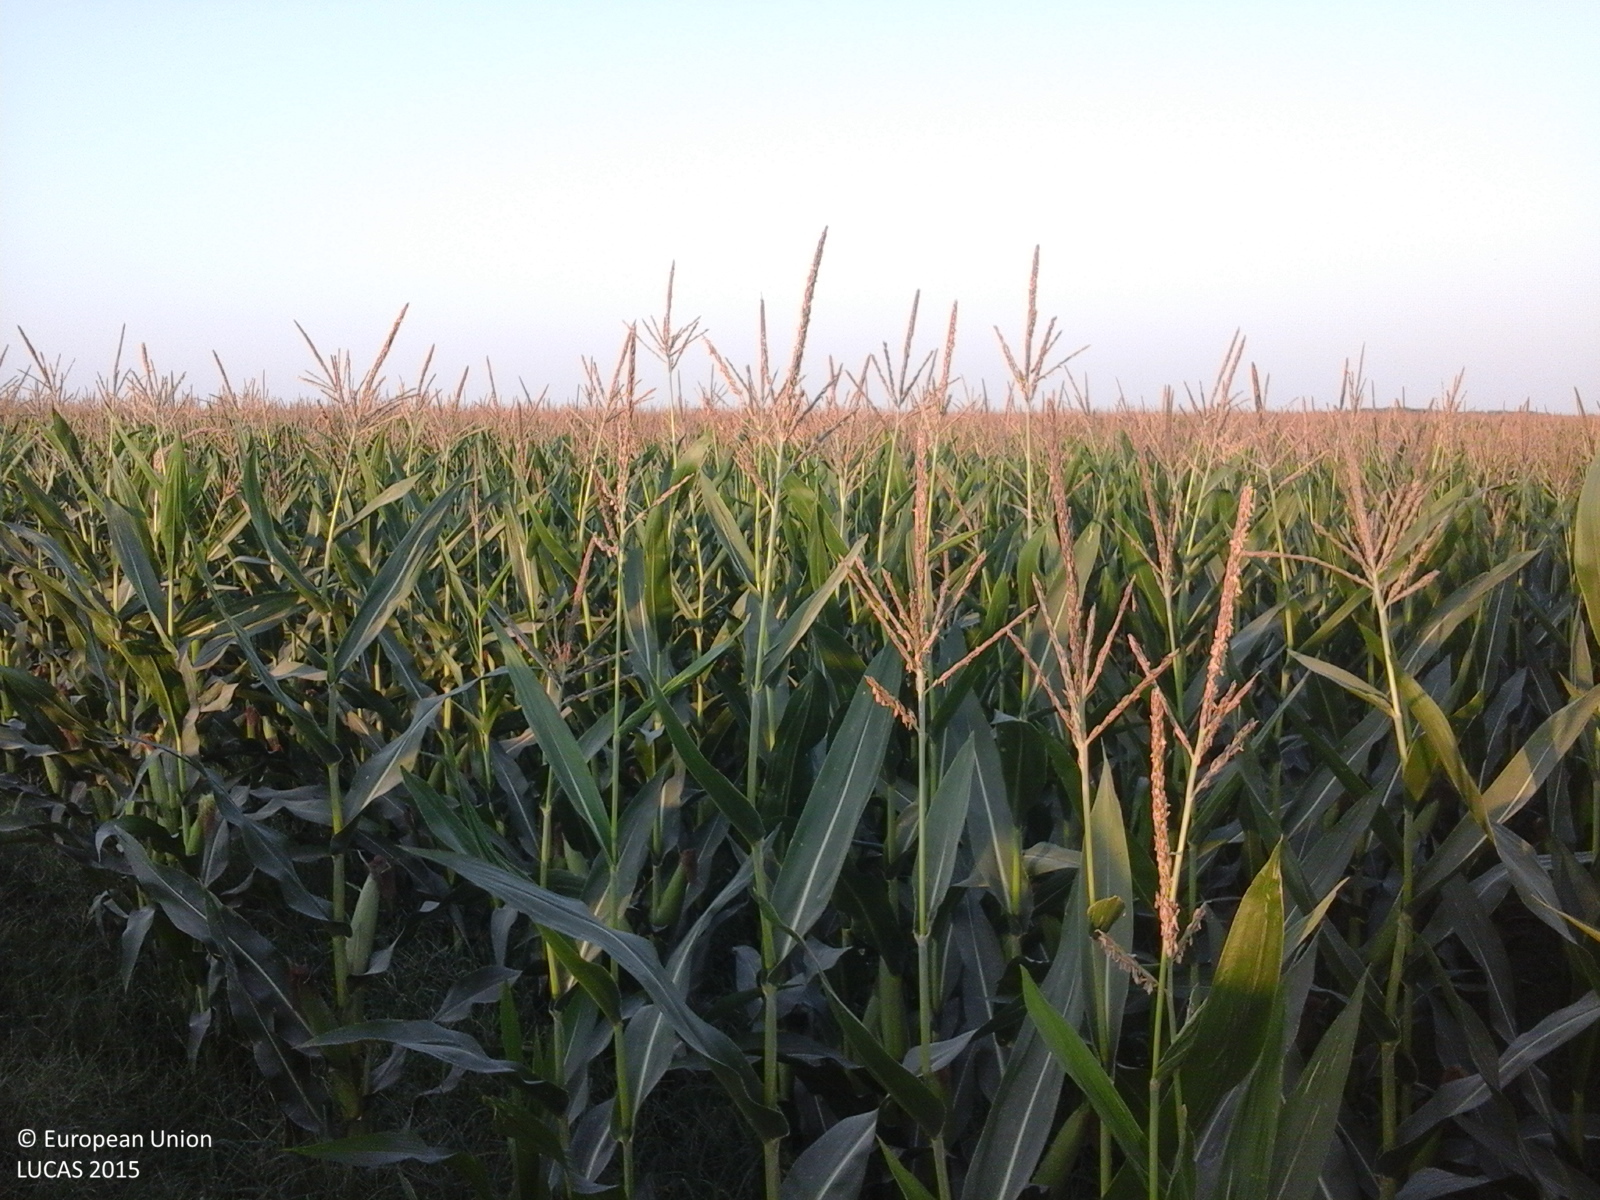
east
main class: Cropland
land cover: Maize
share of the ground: > 75 %
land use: Agriculture (excluding fallow land and kitchen gardens)
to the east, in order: Maize; Common wheat; Maize; Common wheat; Maize
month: July
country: RO
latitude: 45.0968
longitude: 26.9453
